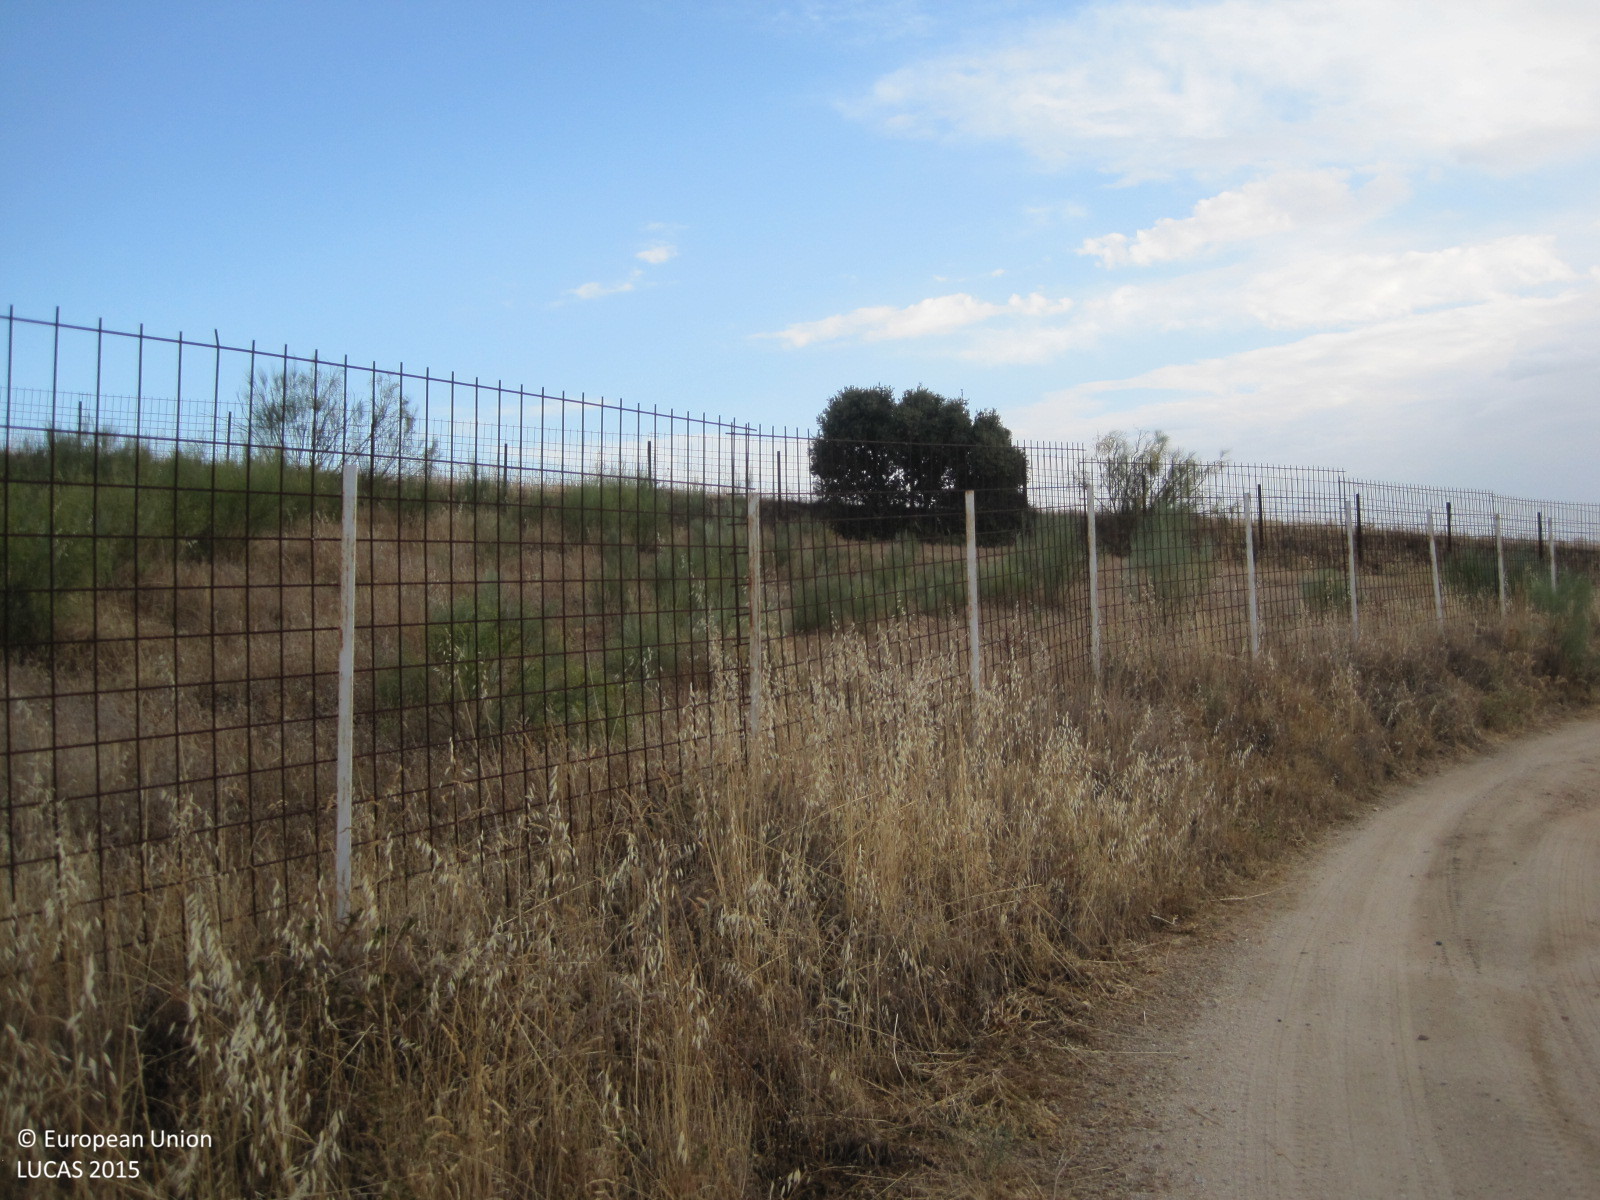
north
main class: Grassland
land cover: Grassland without tree/shrub cover
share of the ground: > 75 %
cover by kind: herbaceous plants 100 %
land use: Agriculture (excluding fallow land and kitchen gardens)
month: July
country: ES
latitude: 40.0774
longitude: -4.2889
